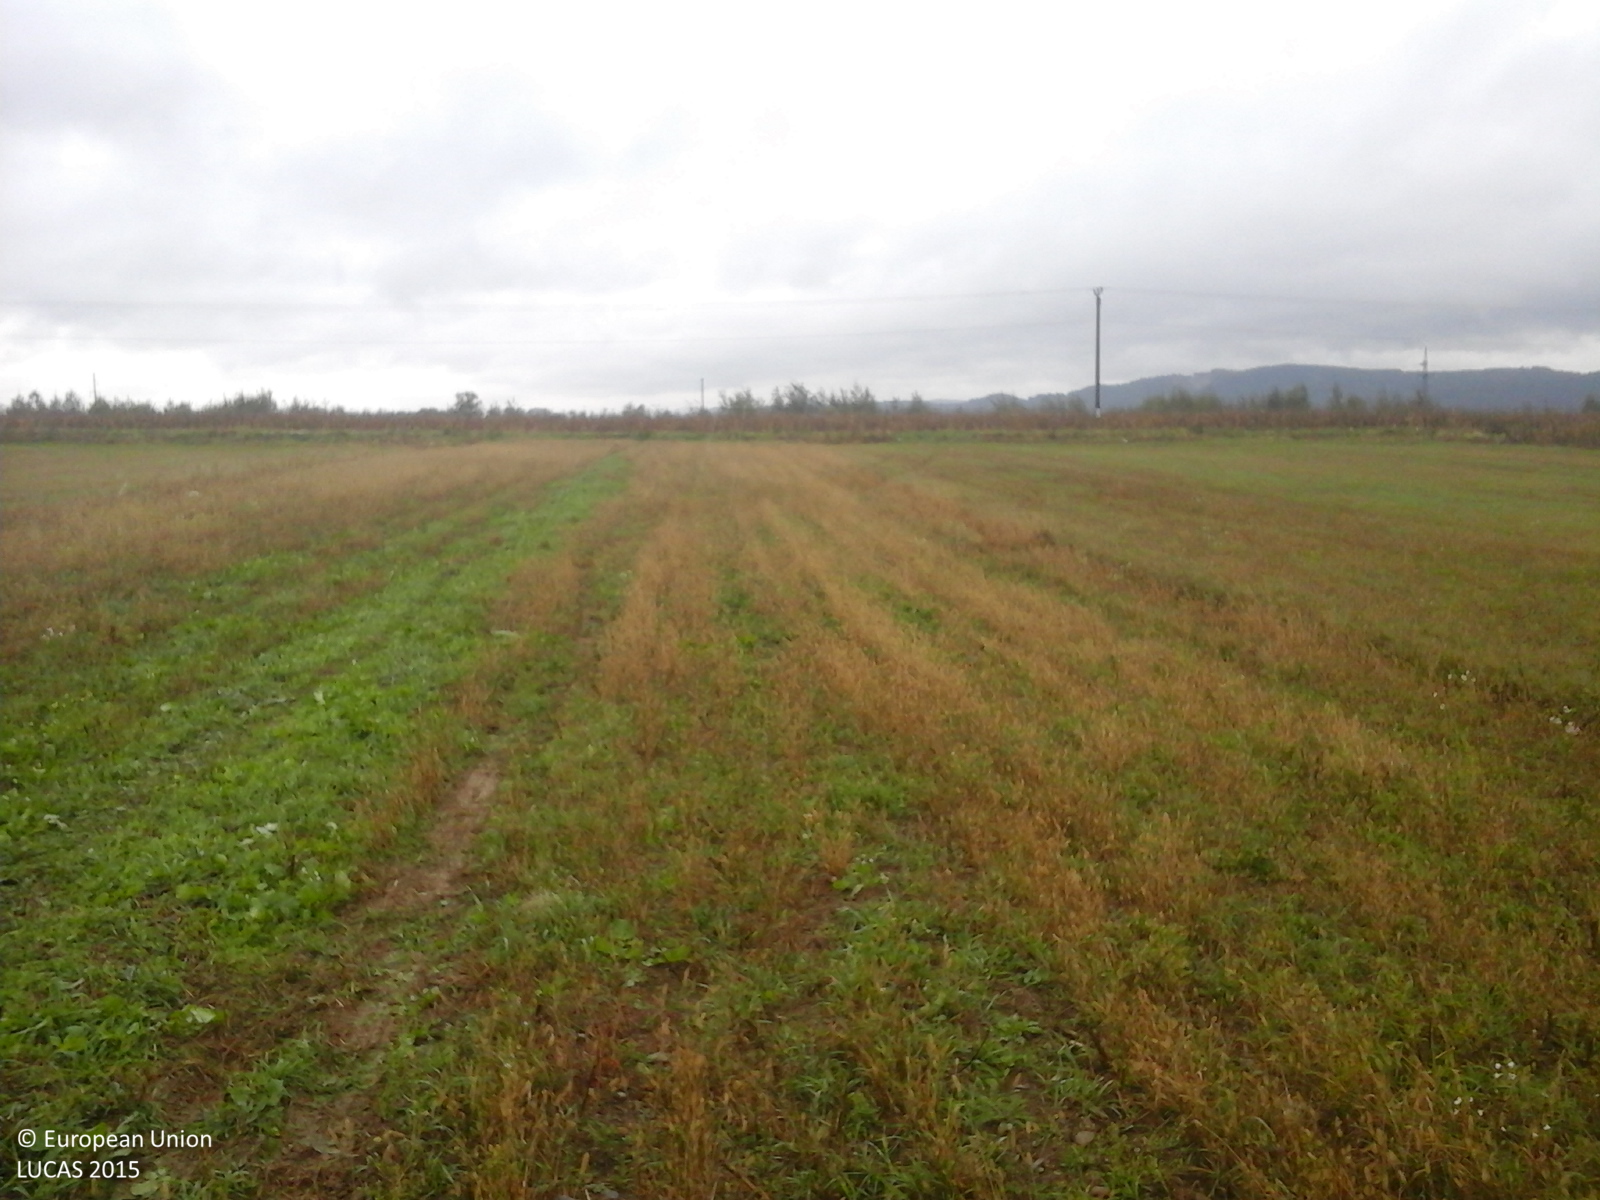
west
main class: Grassland
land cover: Grassland without tree/shrub cover
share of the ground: > 75 %
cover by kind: herbaceous plants 100 %
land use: Agriculture (excluding fallow land and kitchen gardens)
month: October
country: RO
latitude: 45.7811
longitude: 24.6047
